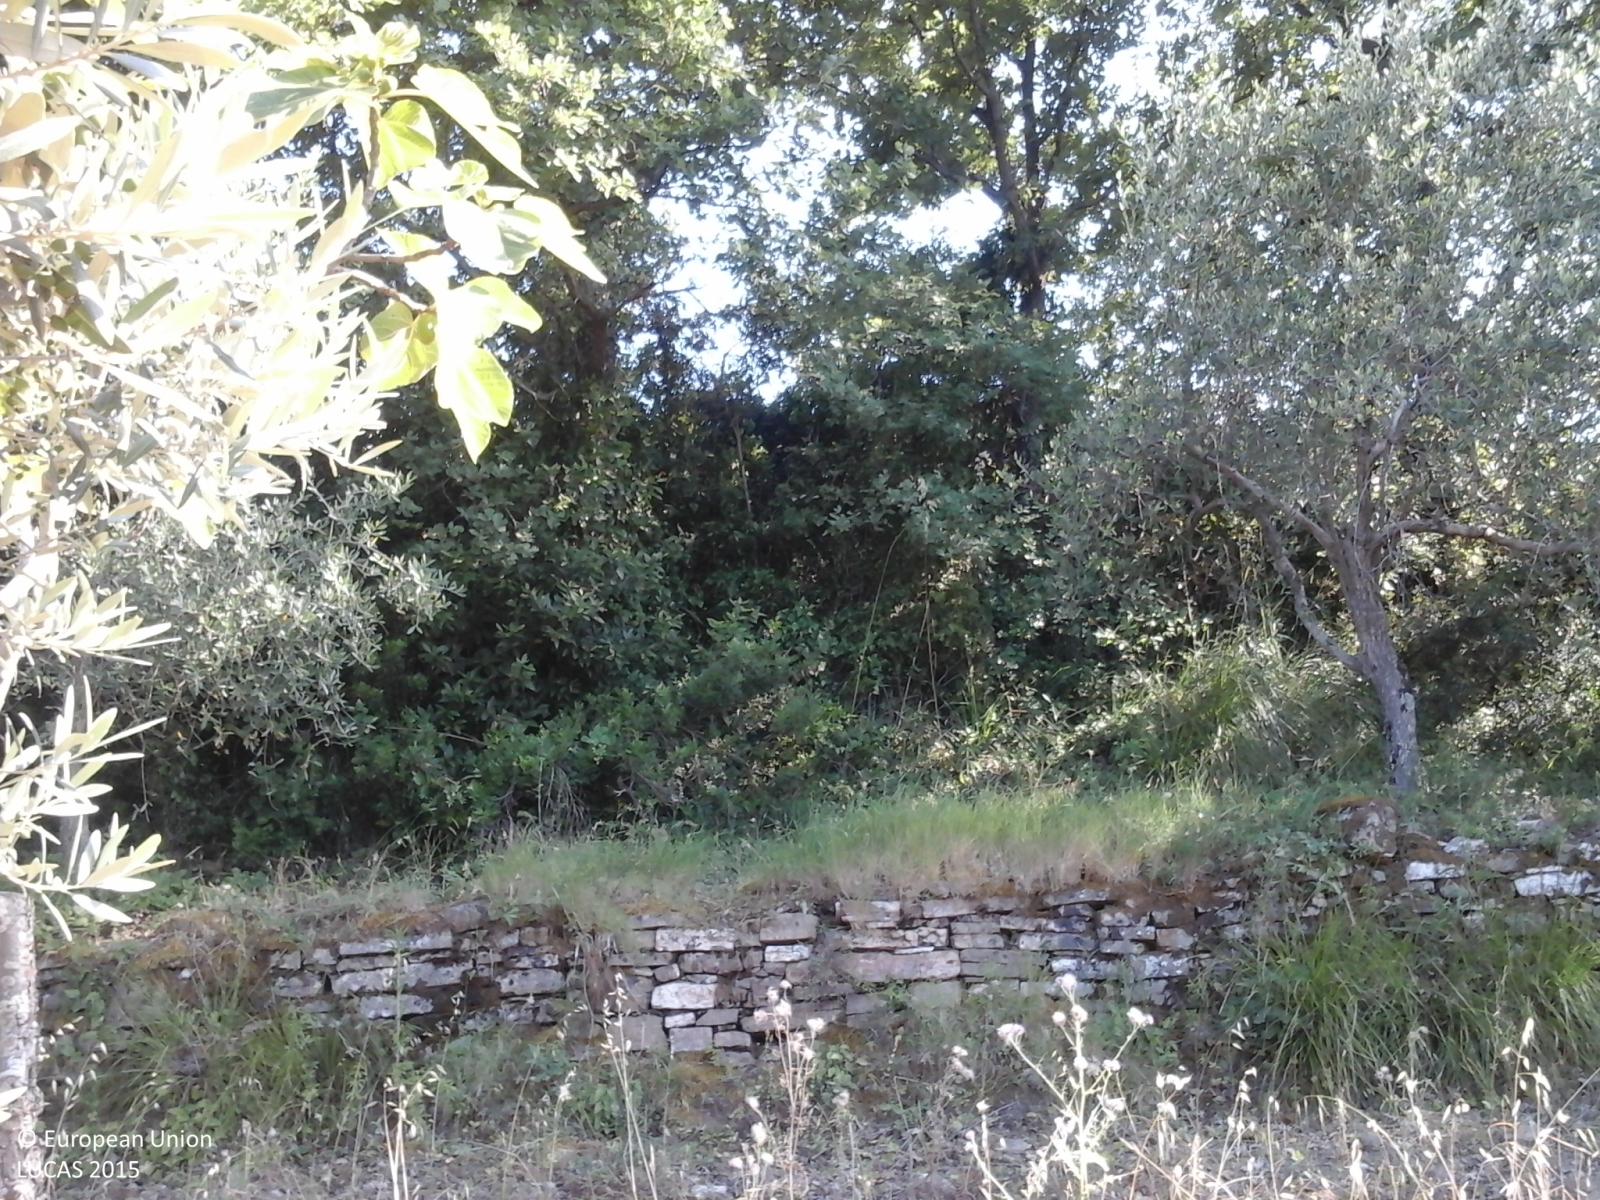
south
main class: Cropland
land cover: Olive groves
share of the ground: 50 - 75 %
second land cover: Other fruit trees and berries
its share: 10 - 25 %
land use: Agriculture (excluding fallow land and kitchen gardens)
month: June
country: IT
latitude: 40.2114
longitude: 15.0180
